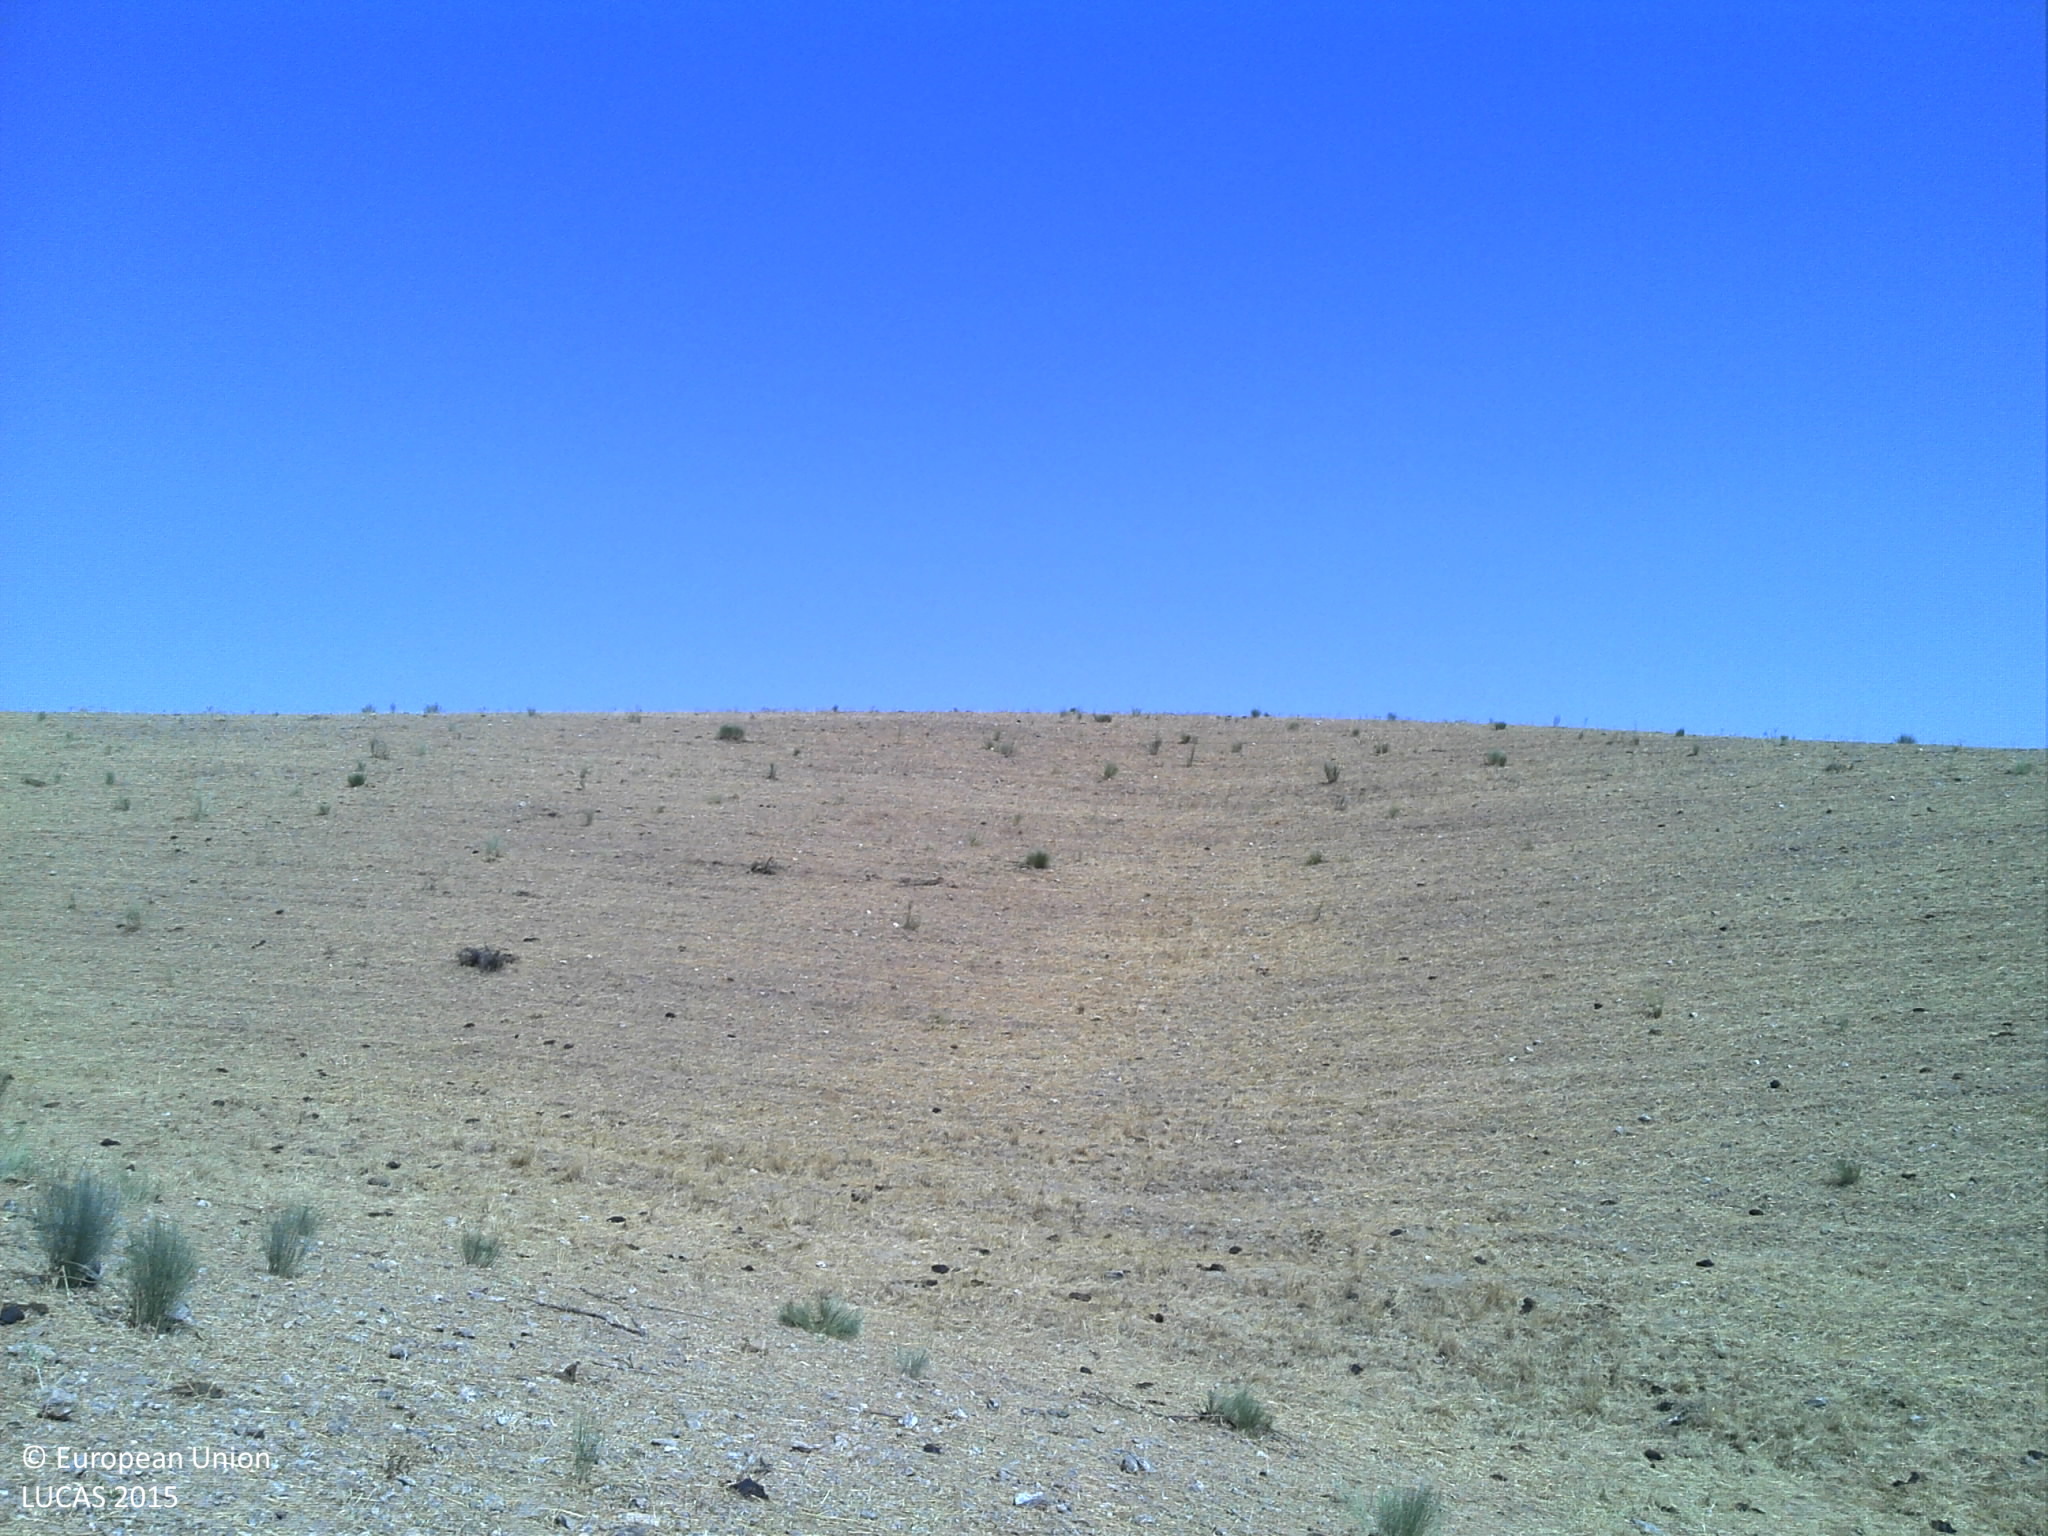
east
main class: Cropland
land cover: Oats
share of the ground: < 10 %
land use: Agriculture (excluding fallow land and kitchen gardens)
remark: Harvested field
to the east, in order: Oats; Fences; Tracks
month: July
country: PT
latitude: 38.4157
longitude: -7.6333
